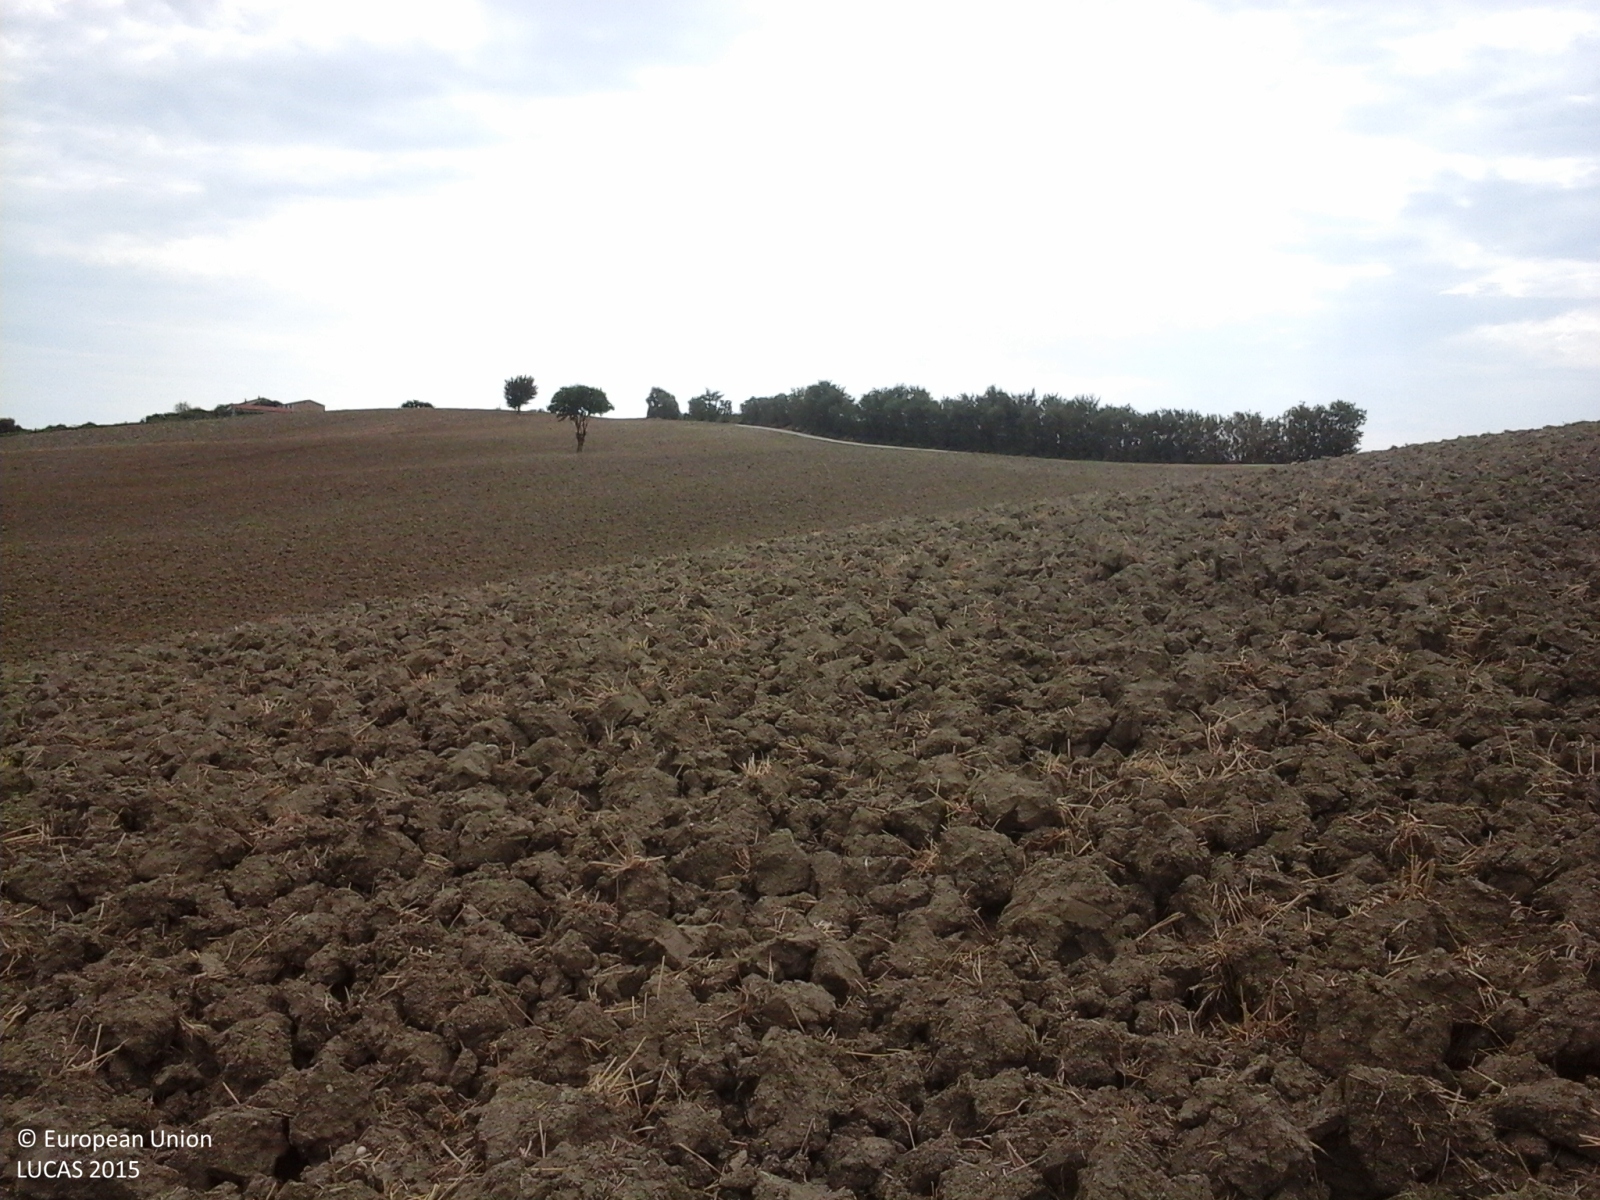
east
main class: Cropland
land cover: Durum wheat
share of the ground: > 75 %
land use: Agriculture (excluding fallow land and kitchen gardens)
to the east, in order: Durum wheat; Grass margins; Paved roads, cycling and walking lanes; Lines of trees
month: August
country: IT
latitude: 43.4121
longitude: 13.3383
